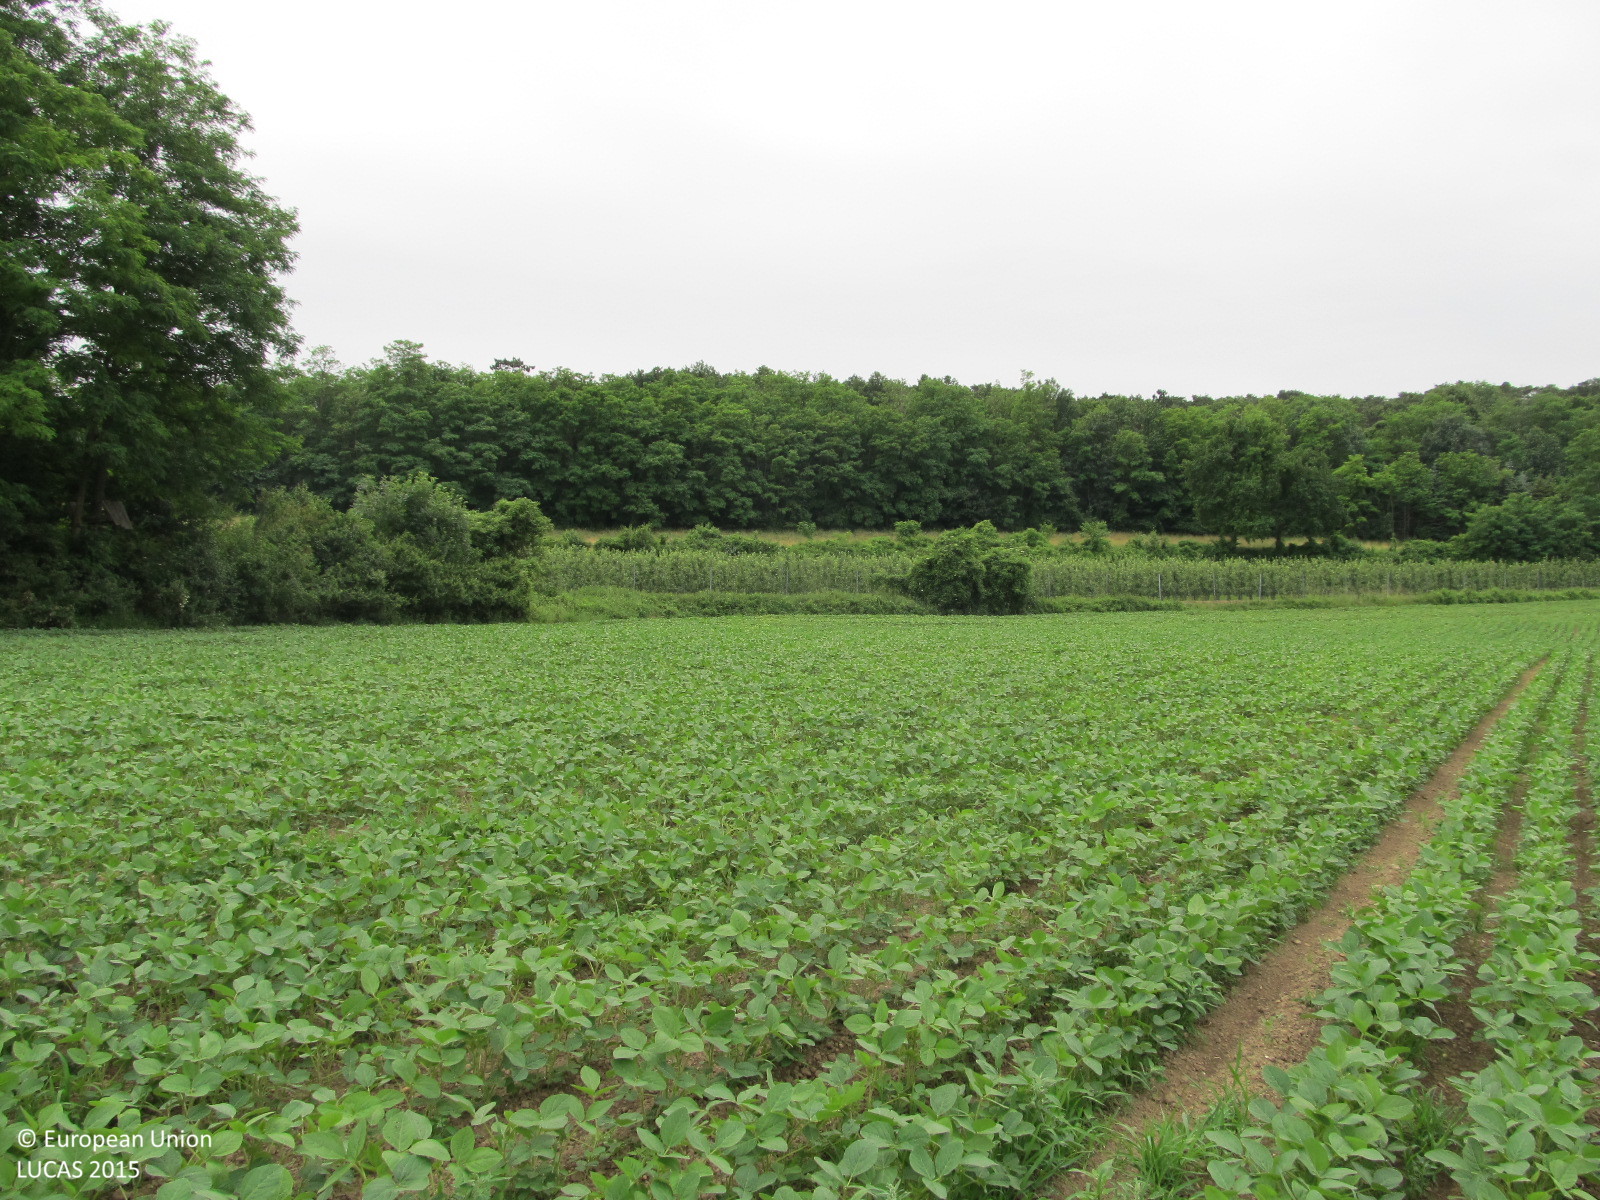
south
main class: Cropland
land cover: Soya
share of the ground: 50 - 75 %
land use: Agriculture (excluding fallow land and kitchen gardens)
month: June
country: AT
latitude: 48.3682
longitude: 15.6319
